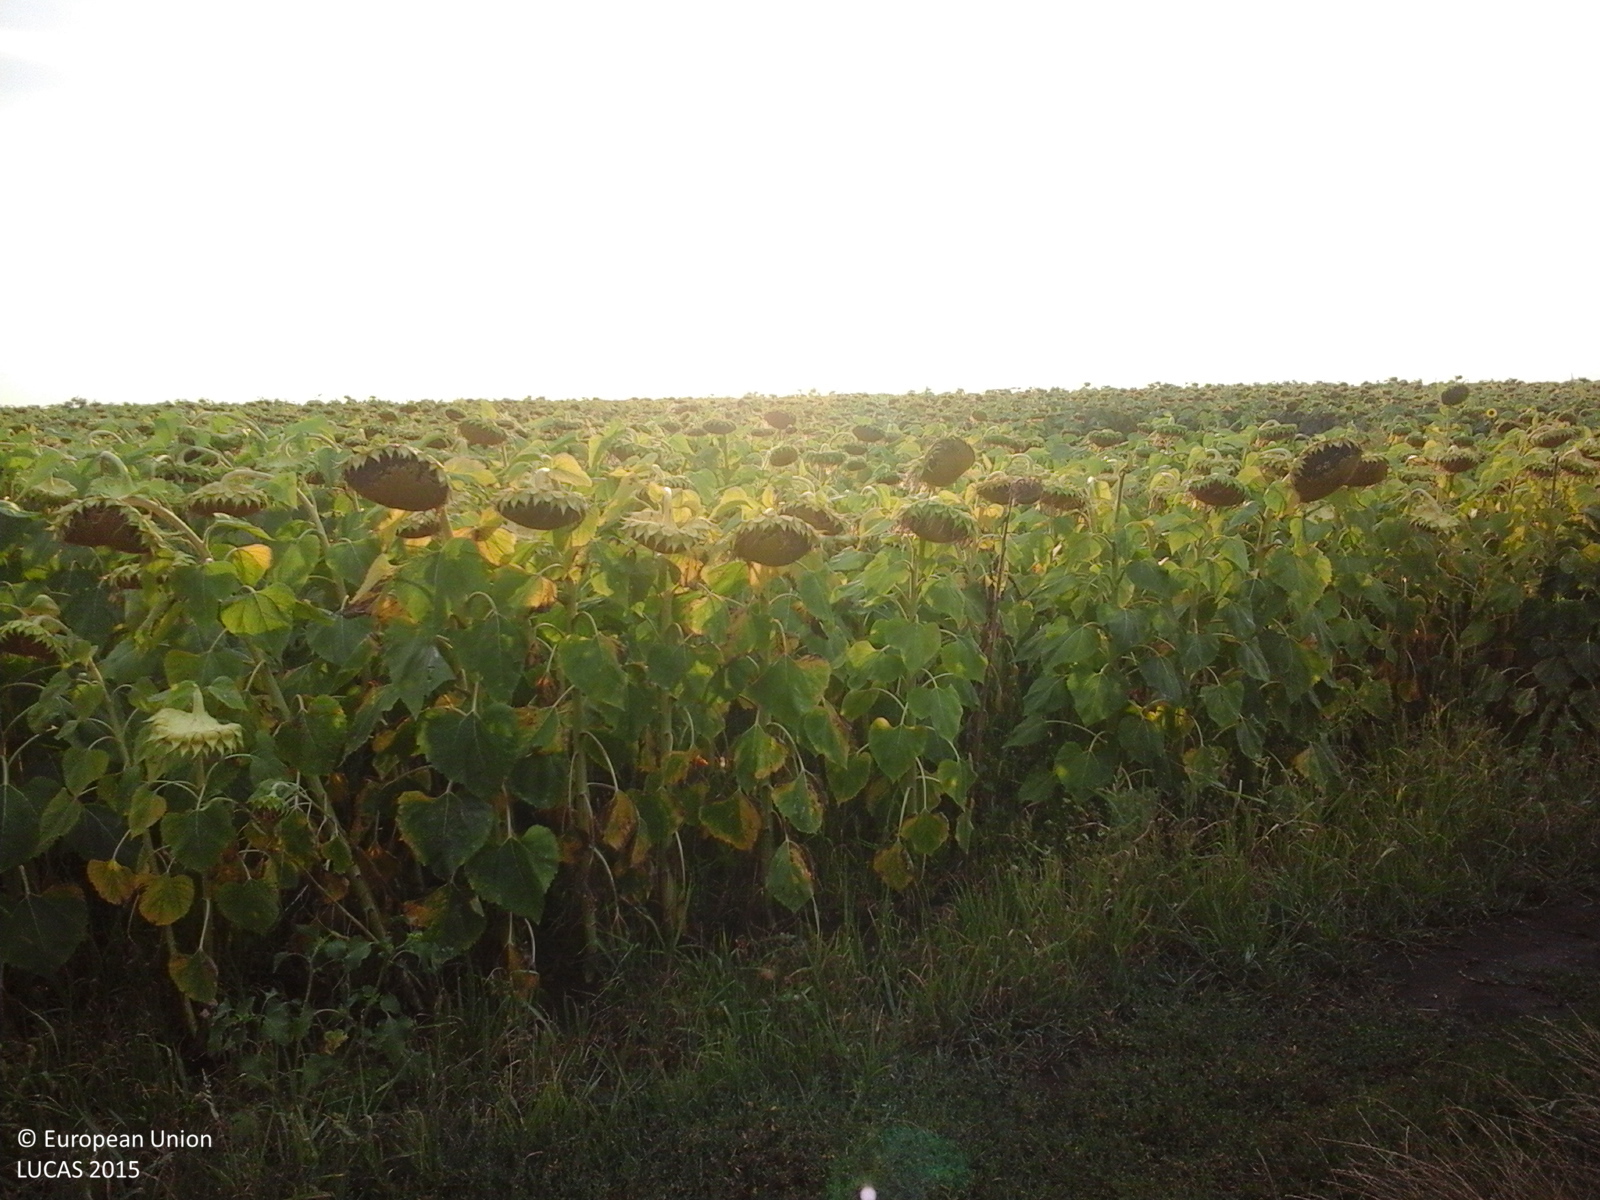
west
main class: Cropland
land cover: Soya
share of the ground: > 75 %
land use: Agriculture (excluding fallow land and kitchen gardens)
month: August
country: RO
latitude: 45.0624
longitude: 27.4836
